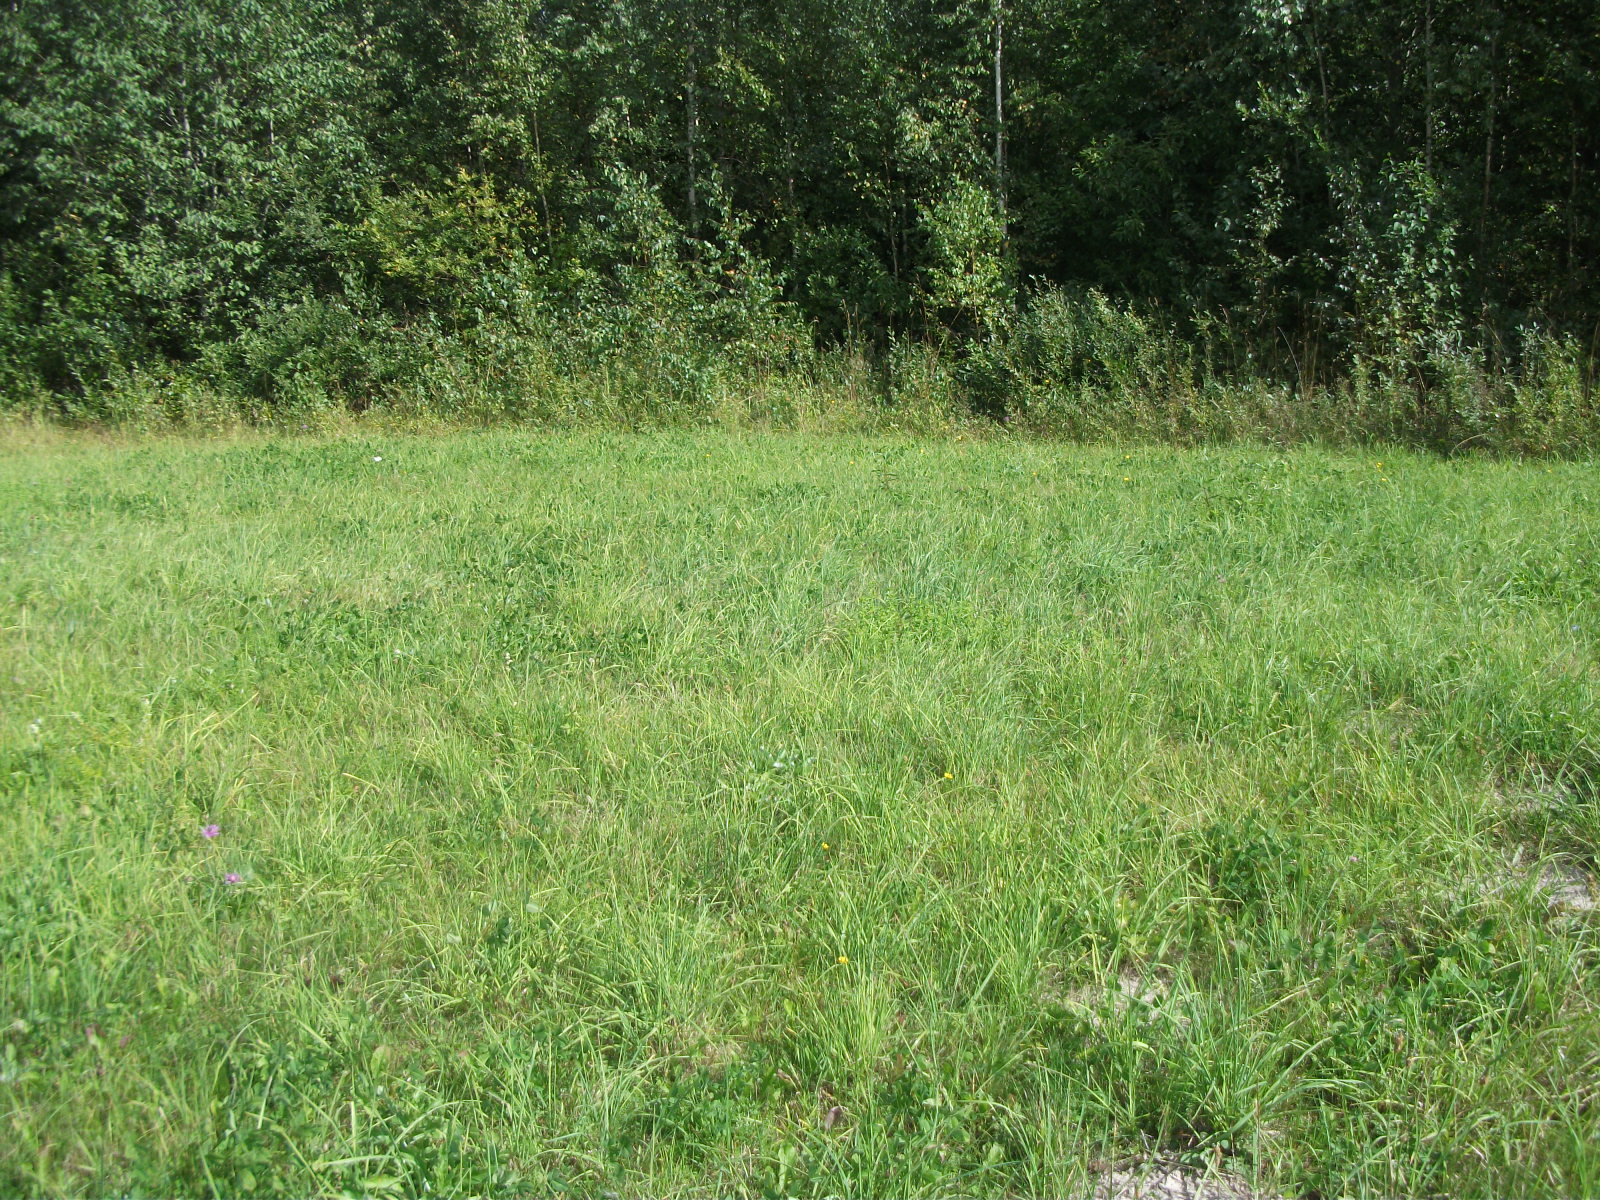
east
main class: Grassland
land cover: Grassland without tree/shrub cover
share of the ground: > 75 %
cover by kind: herbaceous plants 100 %
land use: Agriculture (excluding fallow land and kitchen gardens)
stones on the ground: < 10 %
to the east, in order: Grassland without tree/shrub cover; Broadleaved woodland; Grass margins; Paved roads, cycling and walking lanes; Grass margins; Ditches and canals; Grassland without tree/shrub cover; Potatoes; Grassland without tree/shrub cover
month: August
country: LV
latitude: 56.4310
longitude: 26.3766
